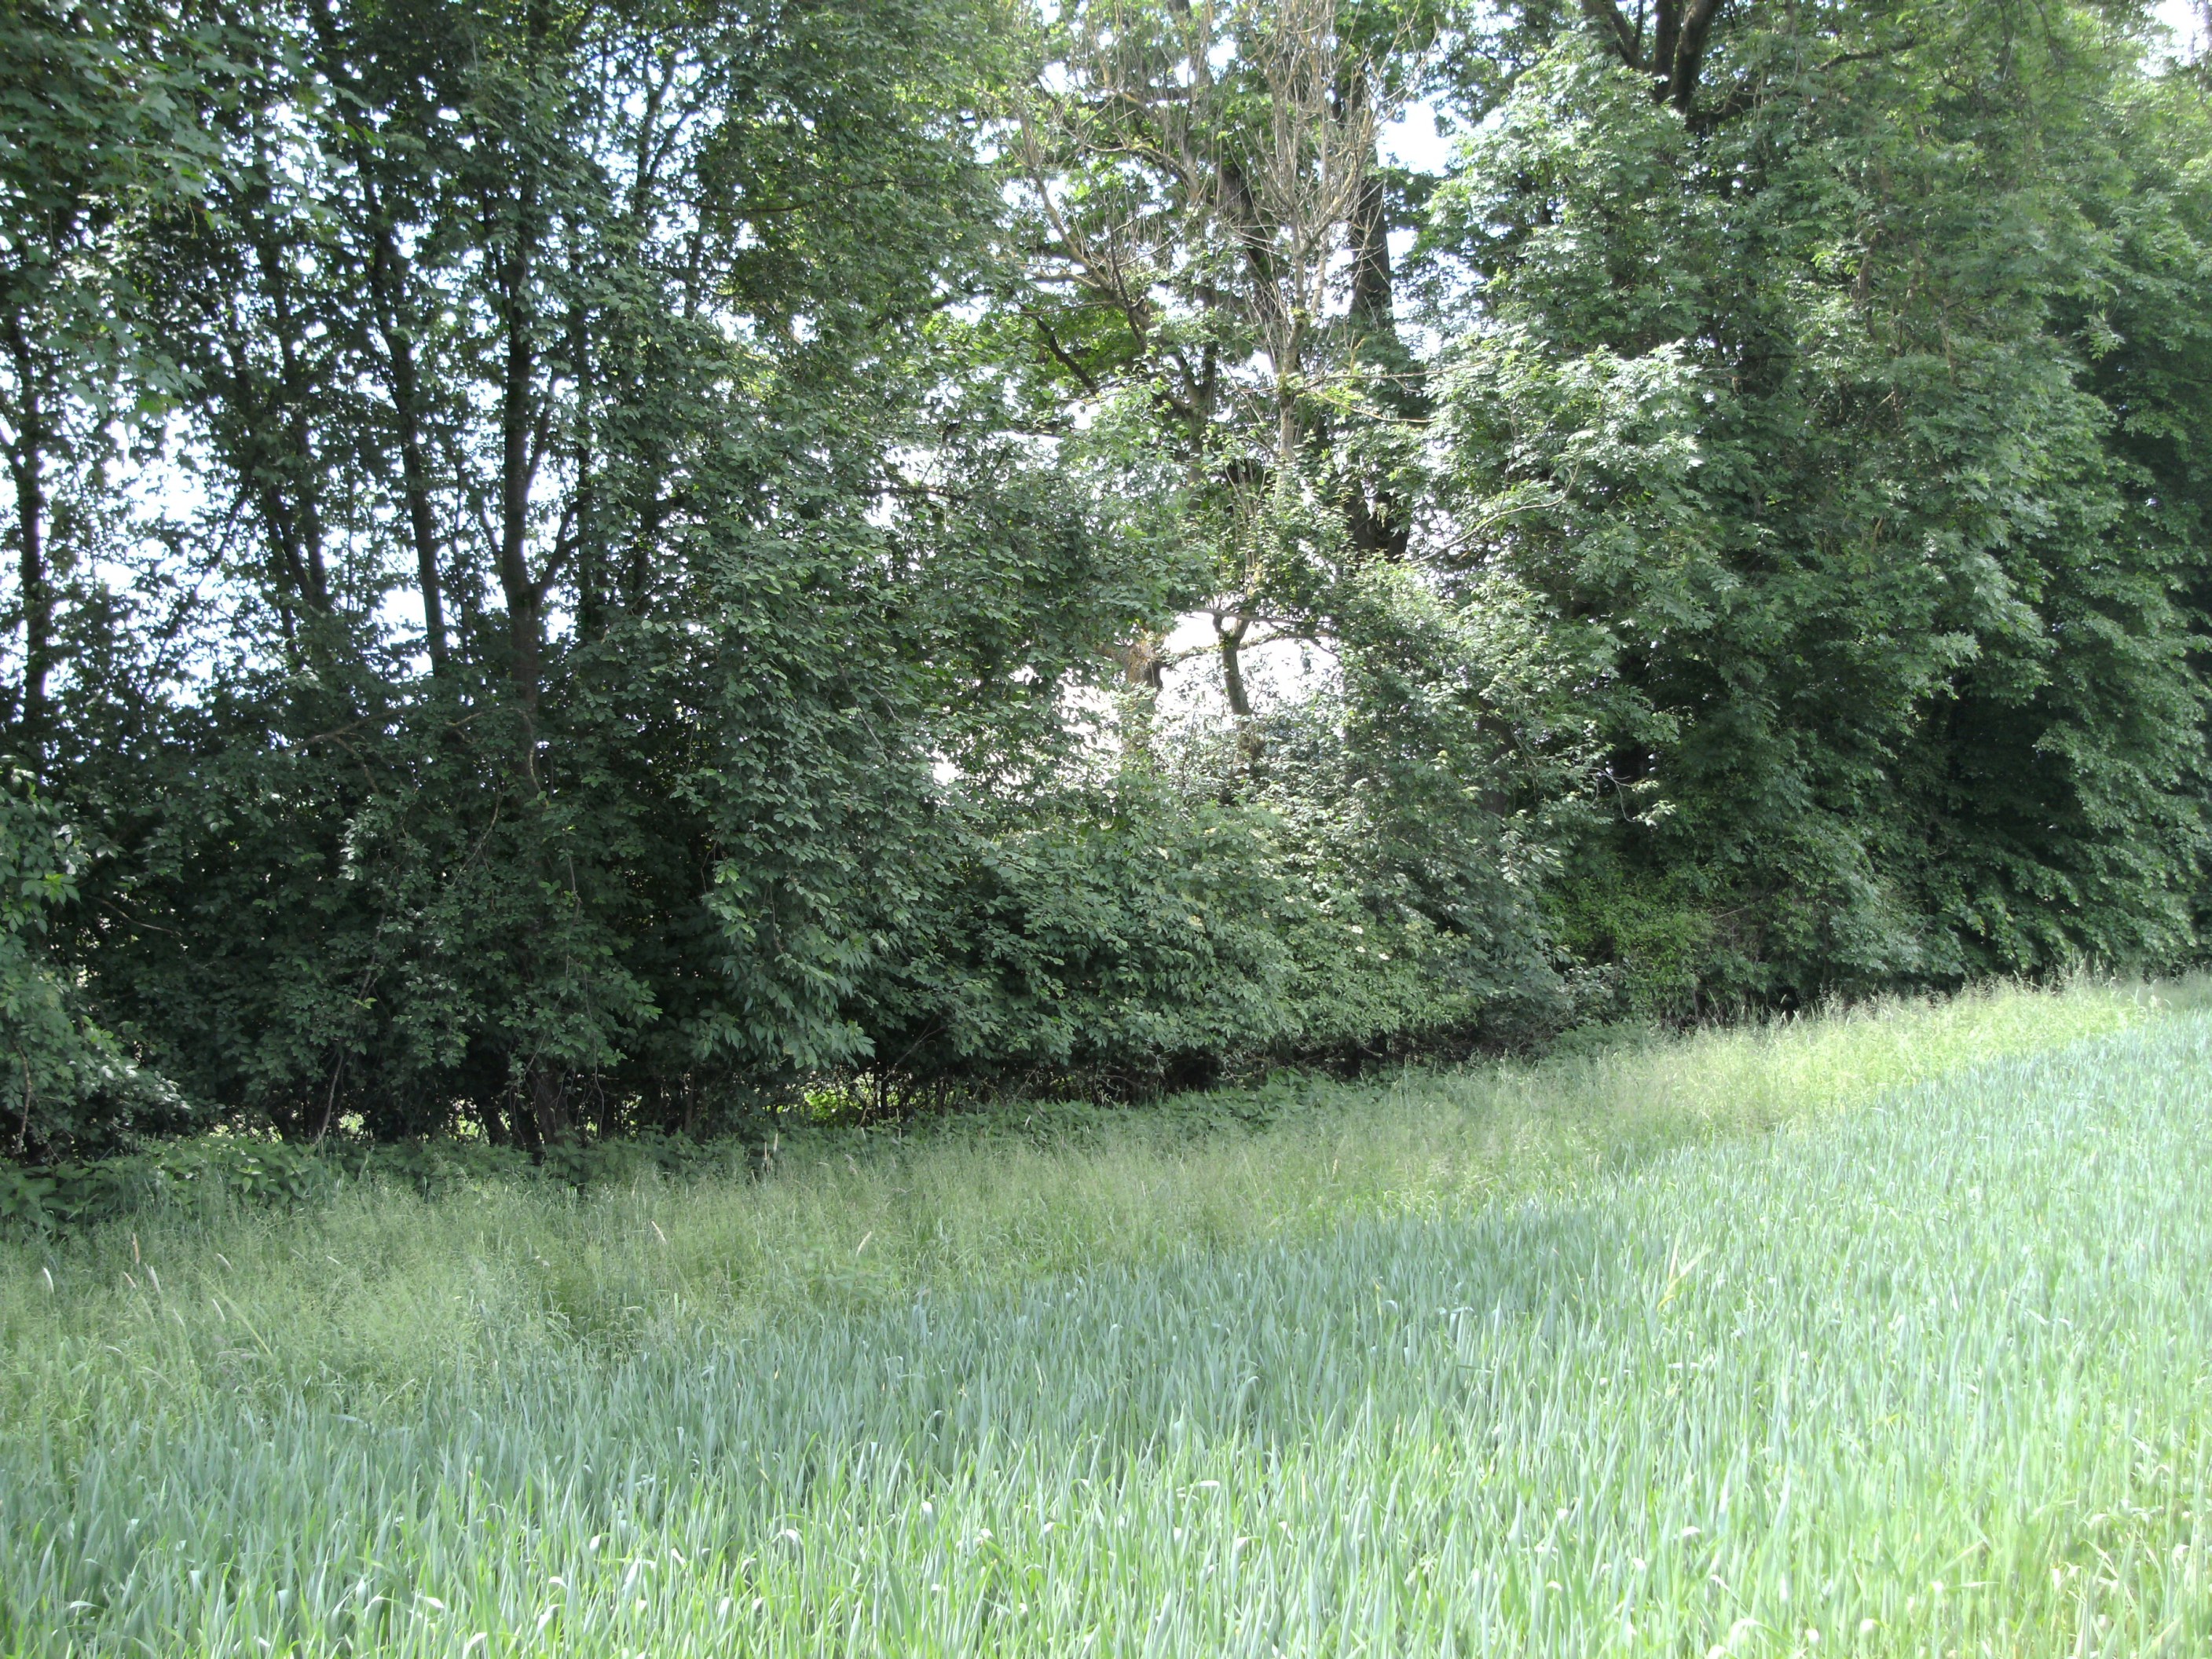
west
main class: Cropland
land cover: Common wheat
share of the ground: > 75 %
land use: Agriculture (excluding fallow land and kitchen gardens)
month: May
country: AT
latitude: 48.0775
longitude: 14.0398
